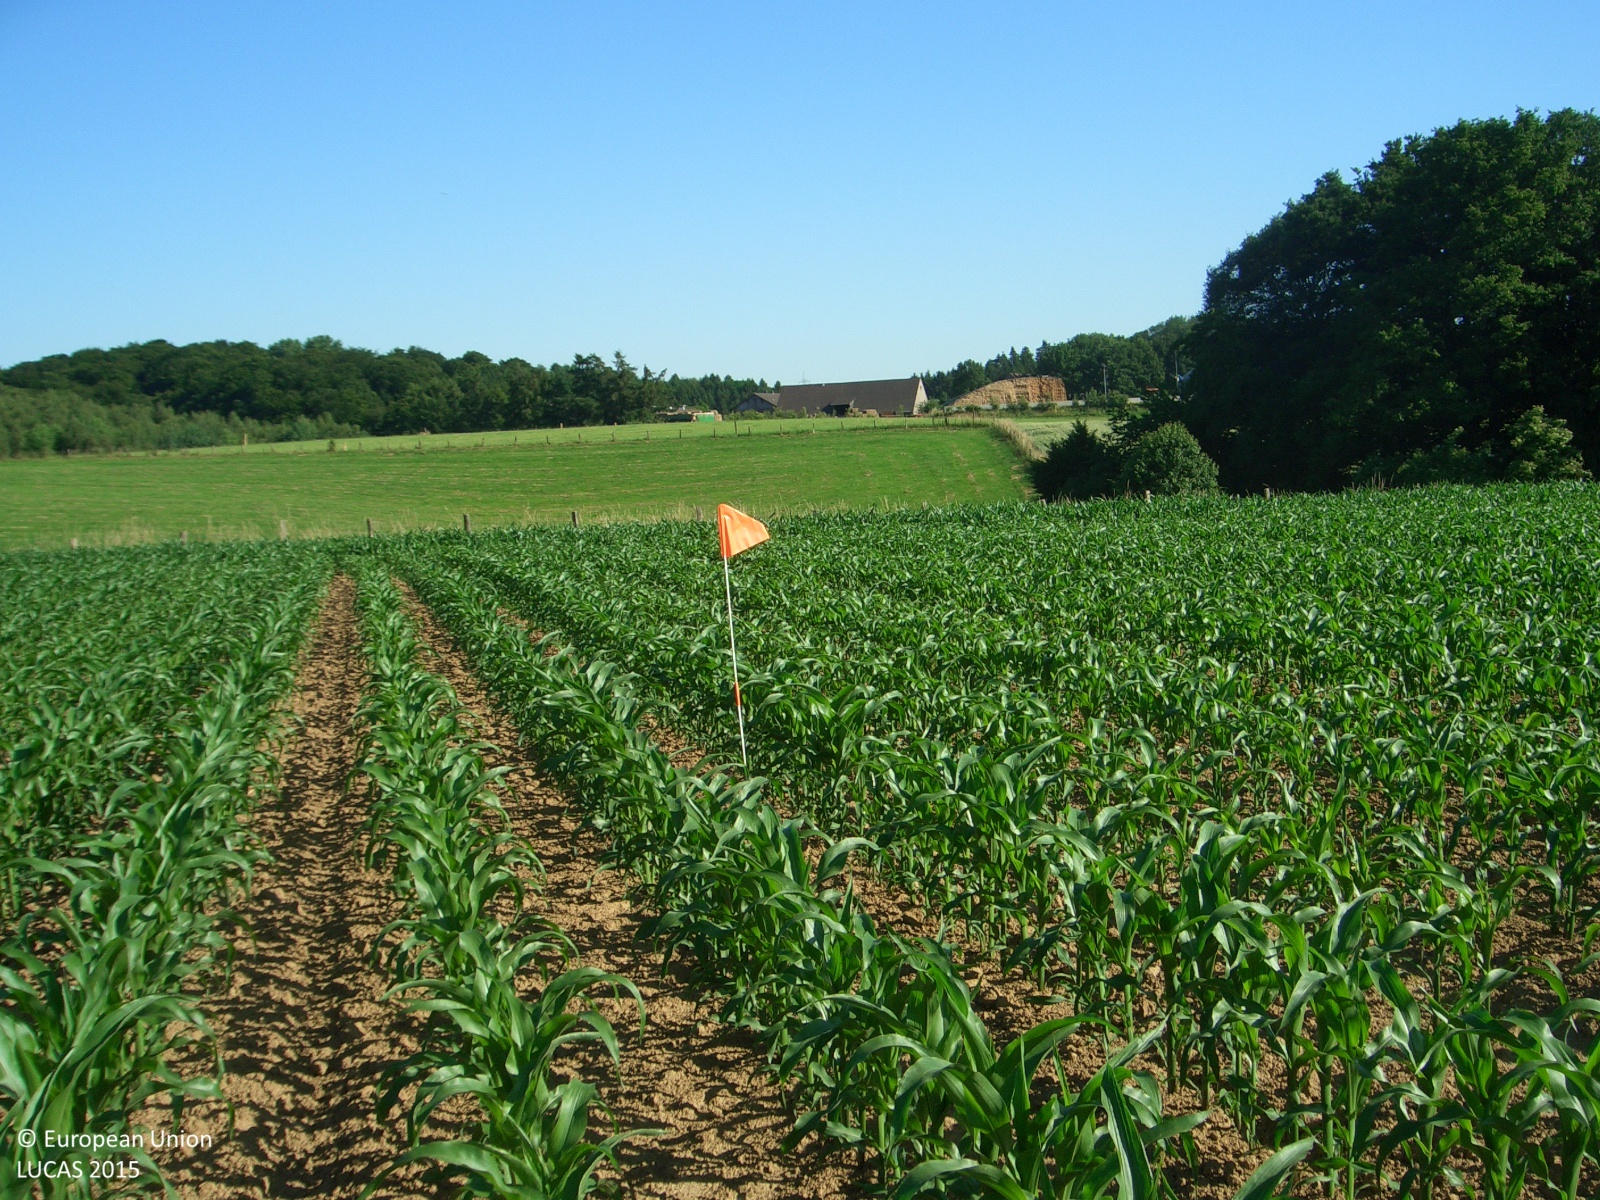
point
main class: Cropland
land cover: Maize
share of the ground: 50 - 75 %
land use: Agriculture (excluding fallow land and kitchen gardens)
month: June
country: DE
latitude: 51.1175
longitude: 7.0428
